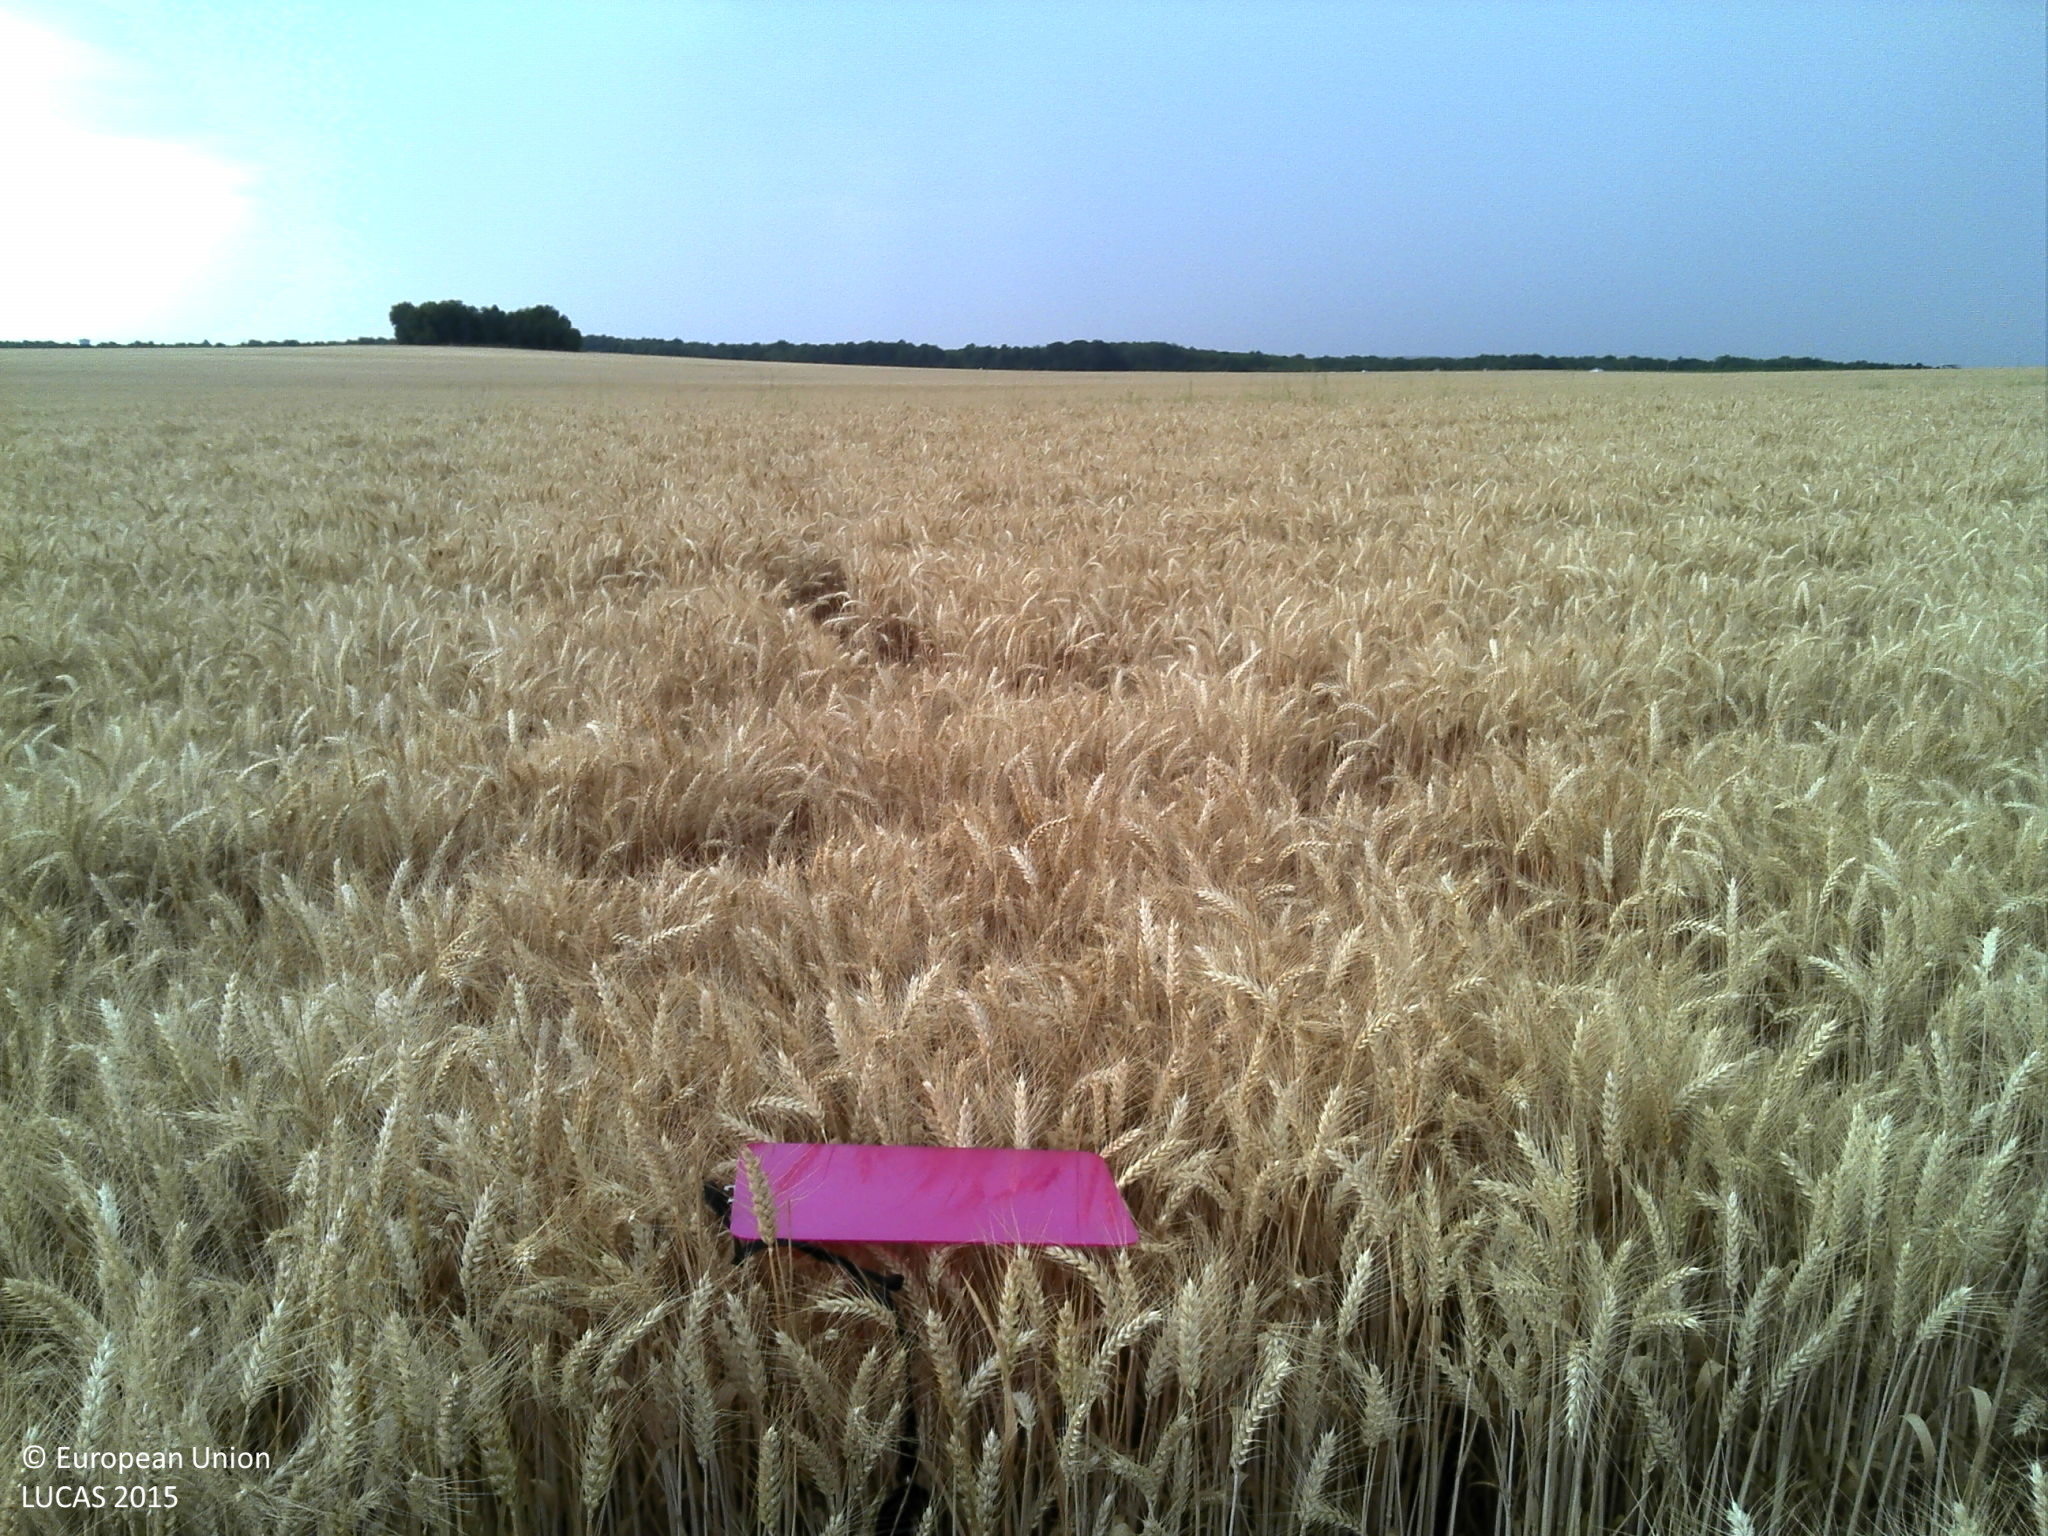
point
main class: Cropland
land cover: Durum wheat
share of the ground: > 75 %
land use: Agriculture (excluding fallow land and kitchen gardens)
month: July
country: FR
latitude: 48.3259
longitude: 2.4499
